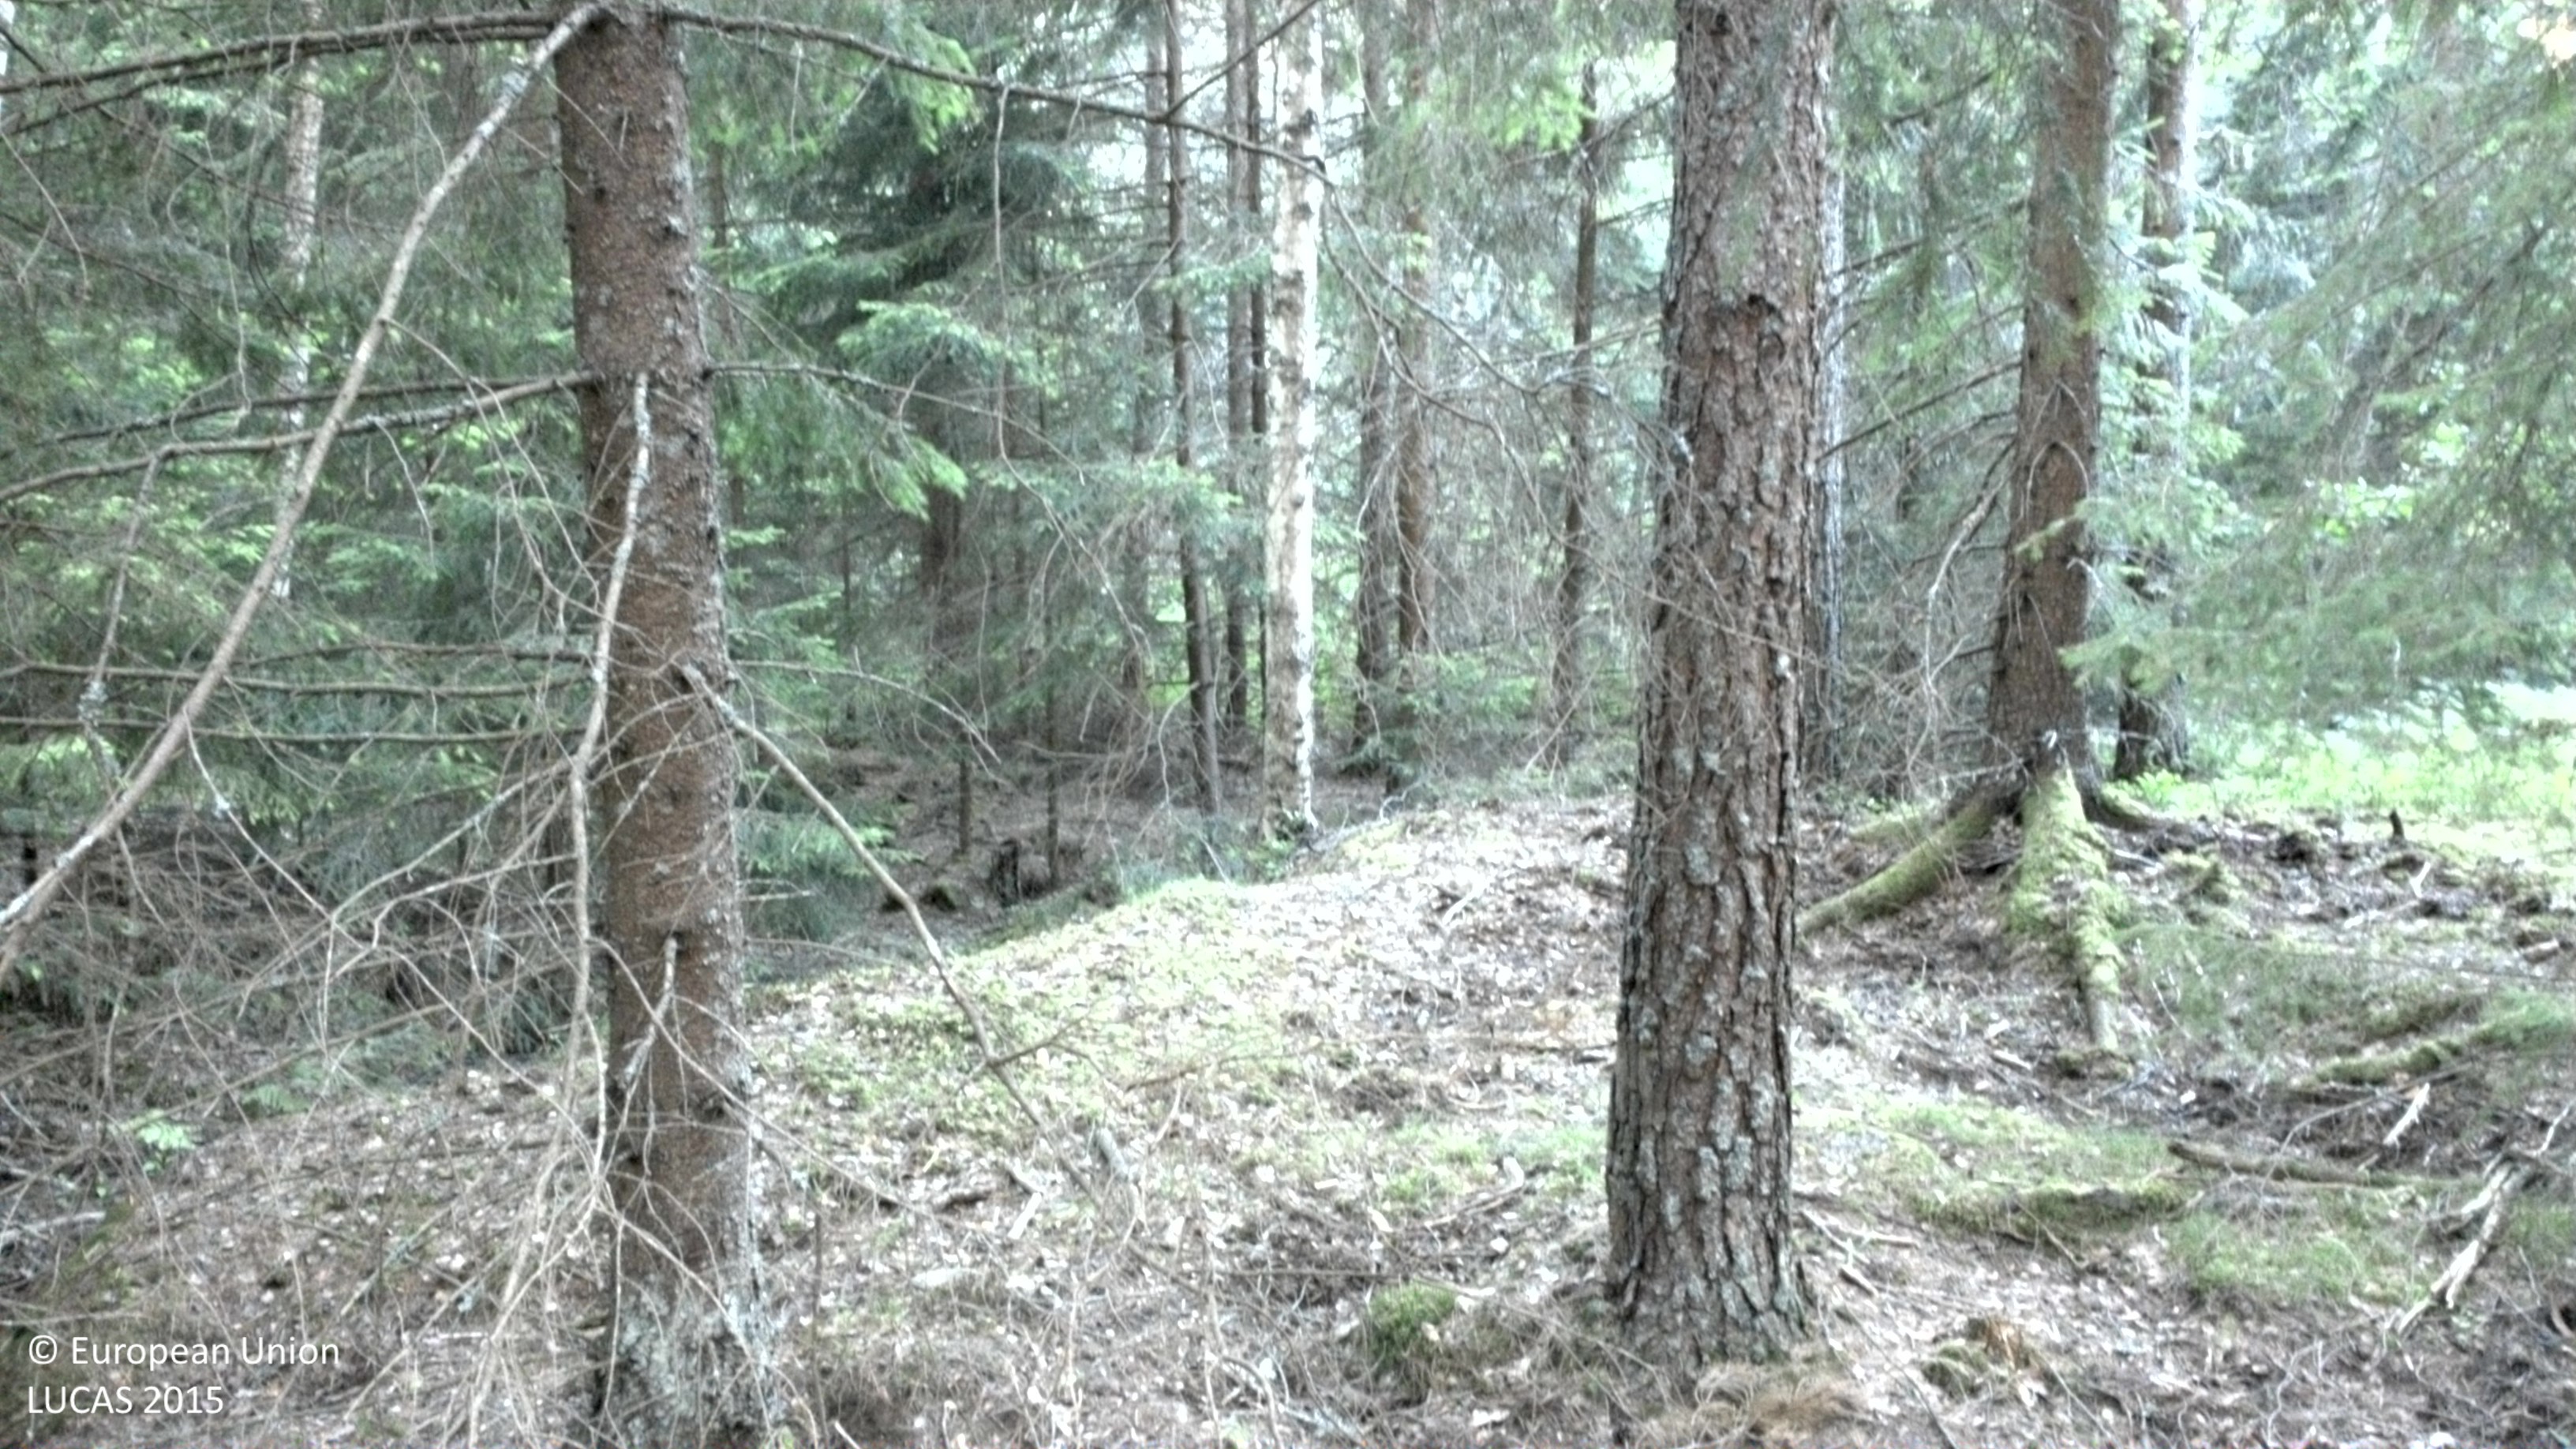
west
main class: Woodland
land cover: Other coniferous woodland
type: boreal forest
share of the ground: > 75 %
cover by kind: coniferous forest trees 65 %, broadleaved forest trees 15 %, shrubs 10 %, lichens and mosses 10 %
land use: Forestry
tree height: > 5 m
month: June
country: SE
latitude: 58.3518
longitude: 15.6849
